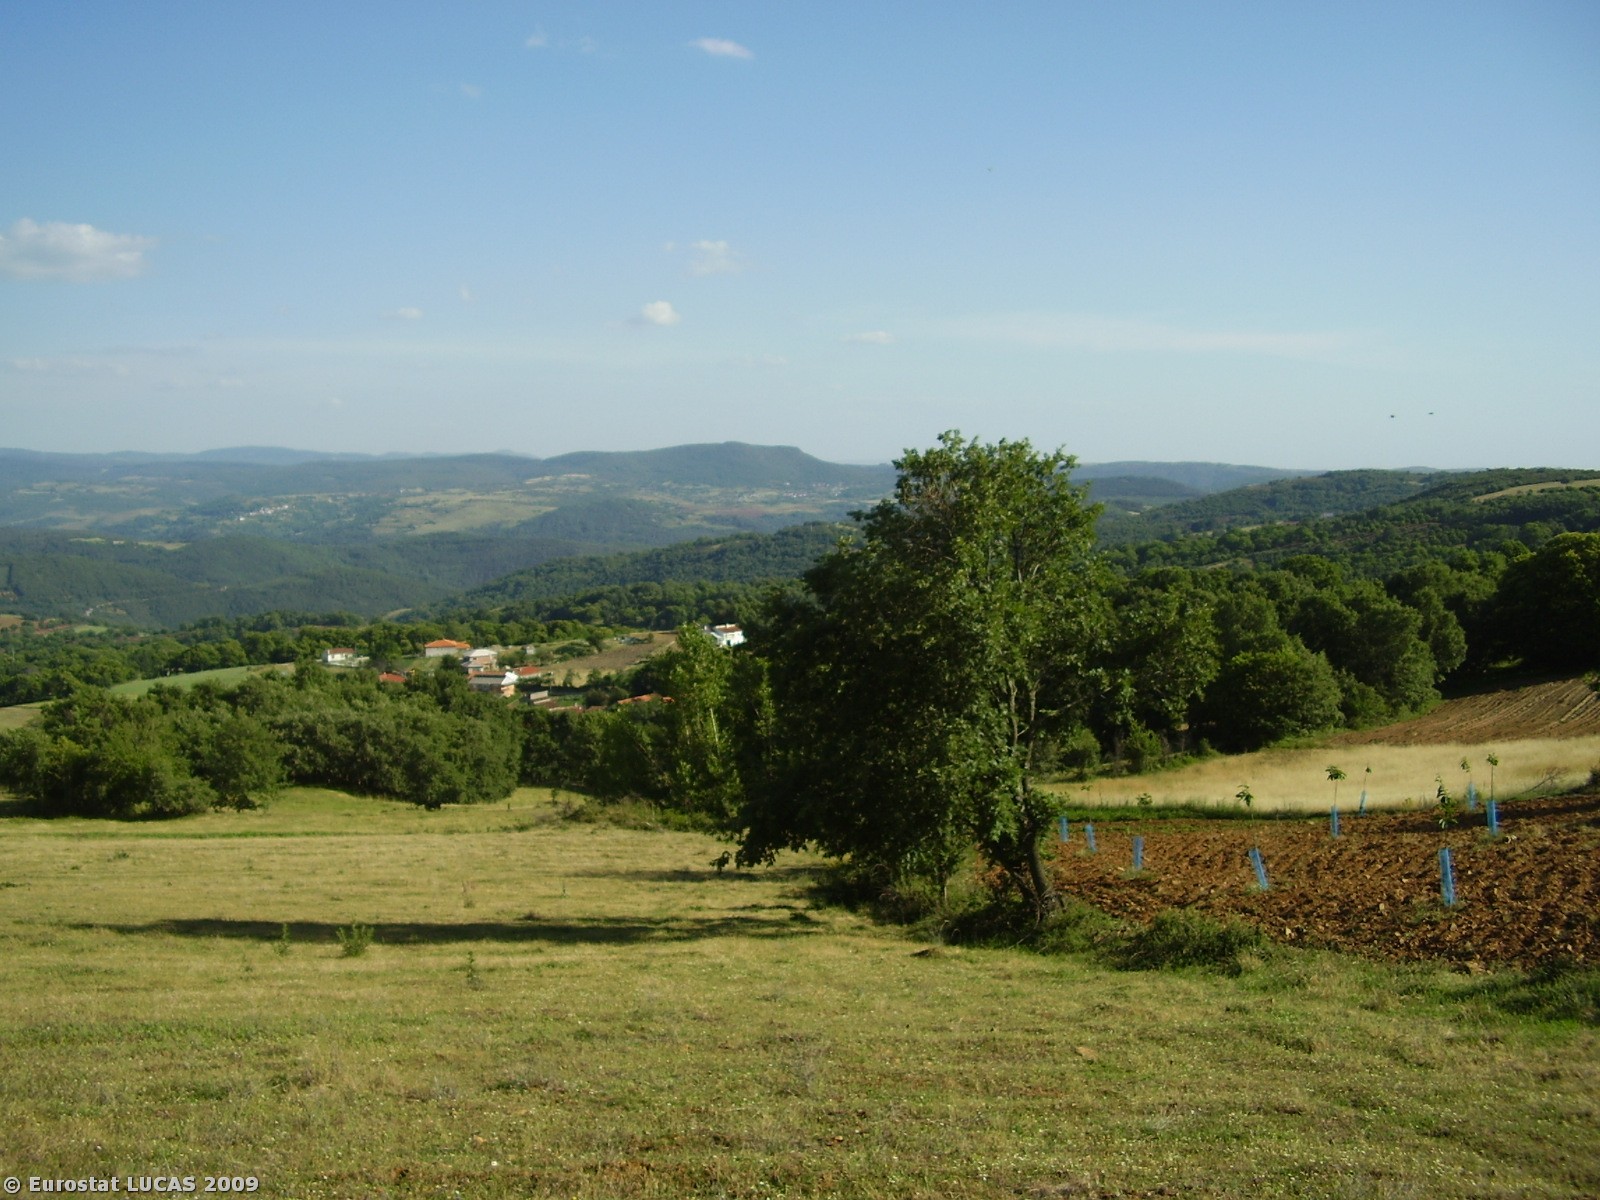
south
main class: Shrubland
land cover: Shrubland without tree cover
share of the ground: > 75 %
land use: Nature reserves
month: June
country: PT
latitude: 41.8757
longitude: -6.9519
